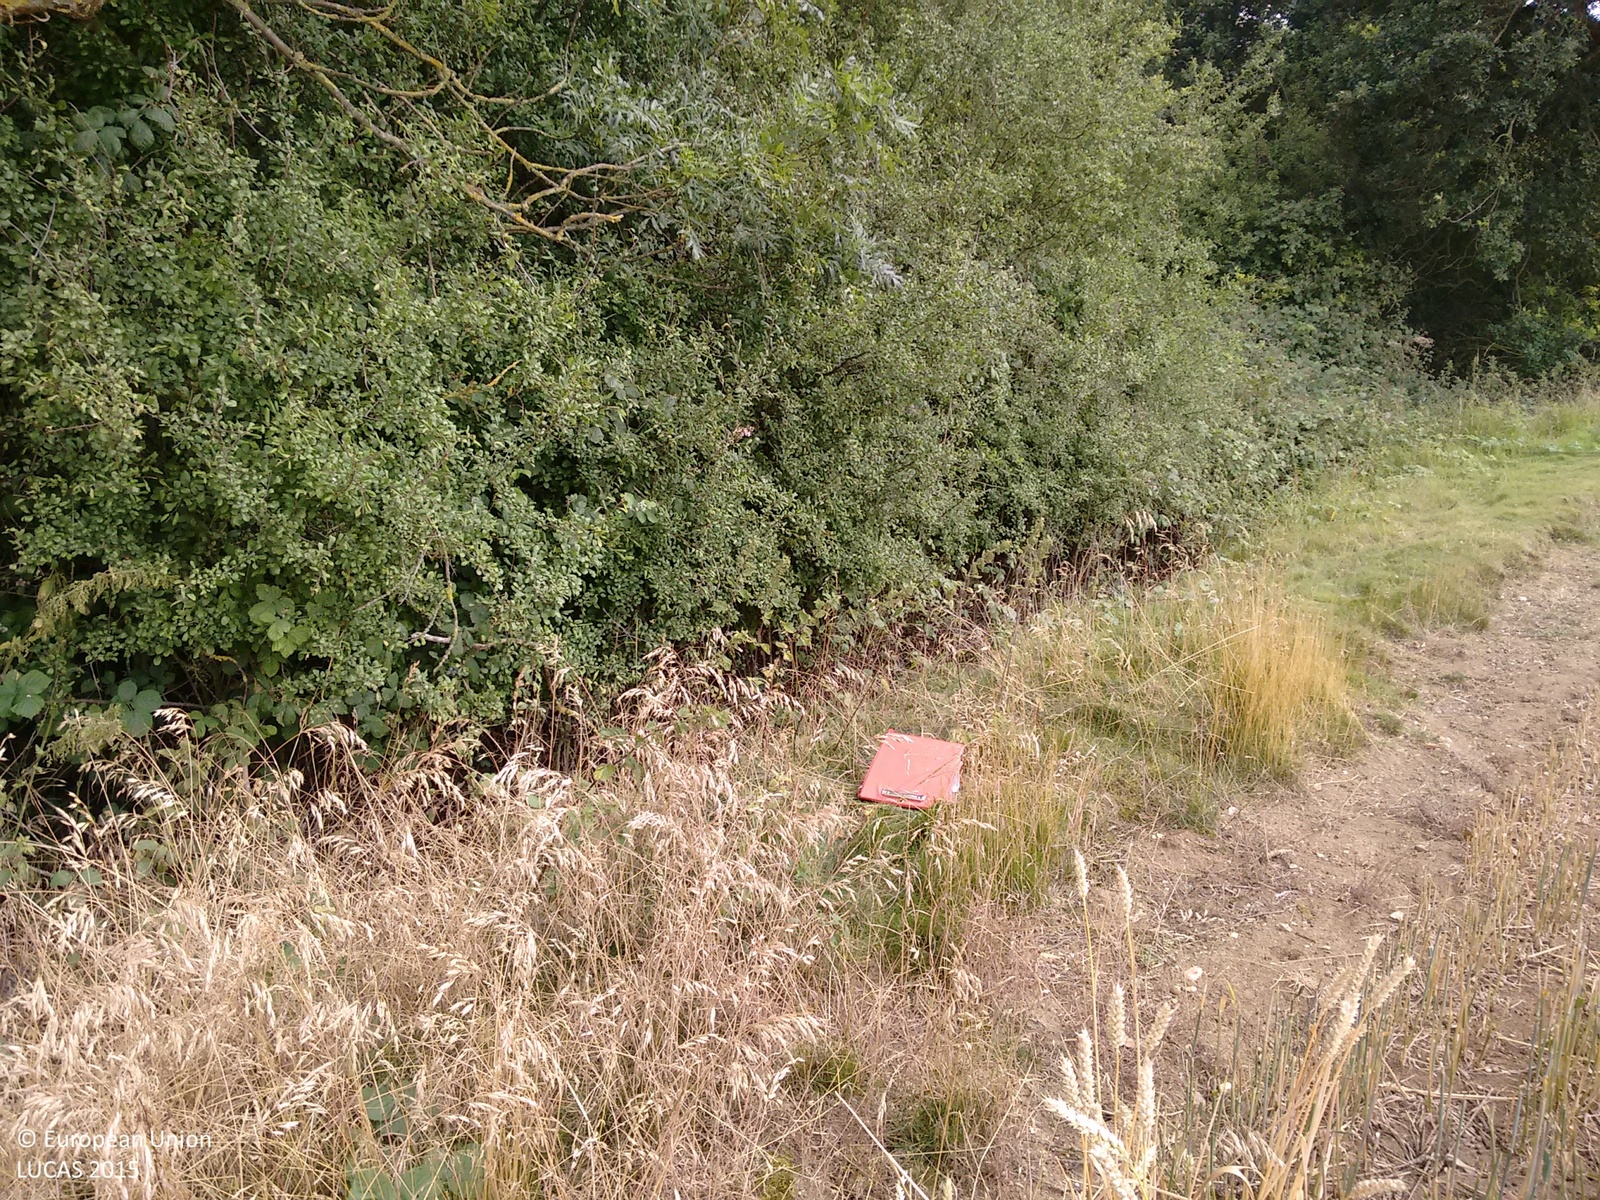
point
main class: Cropland
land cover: Common wheat
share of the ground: > 75 %
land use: Agriculture (excluding fallow land and kitchen gardens)
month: July
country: GB
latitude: 51.9346
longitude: 0.4156
